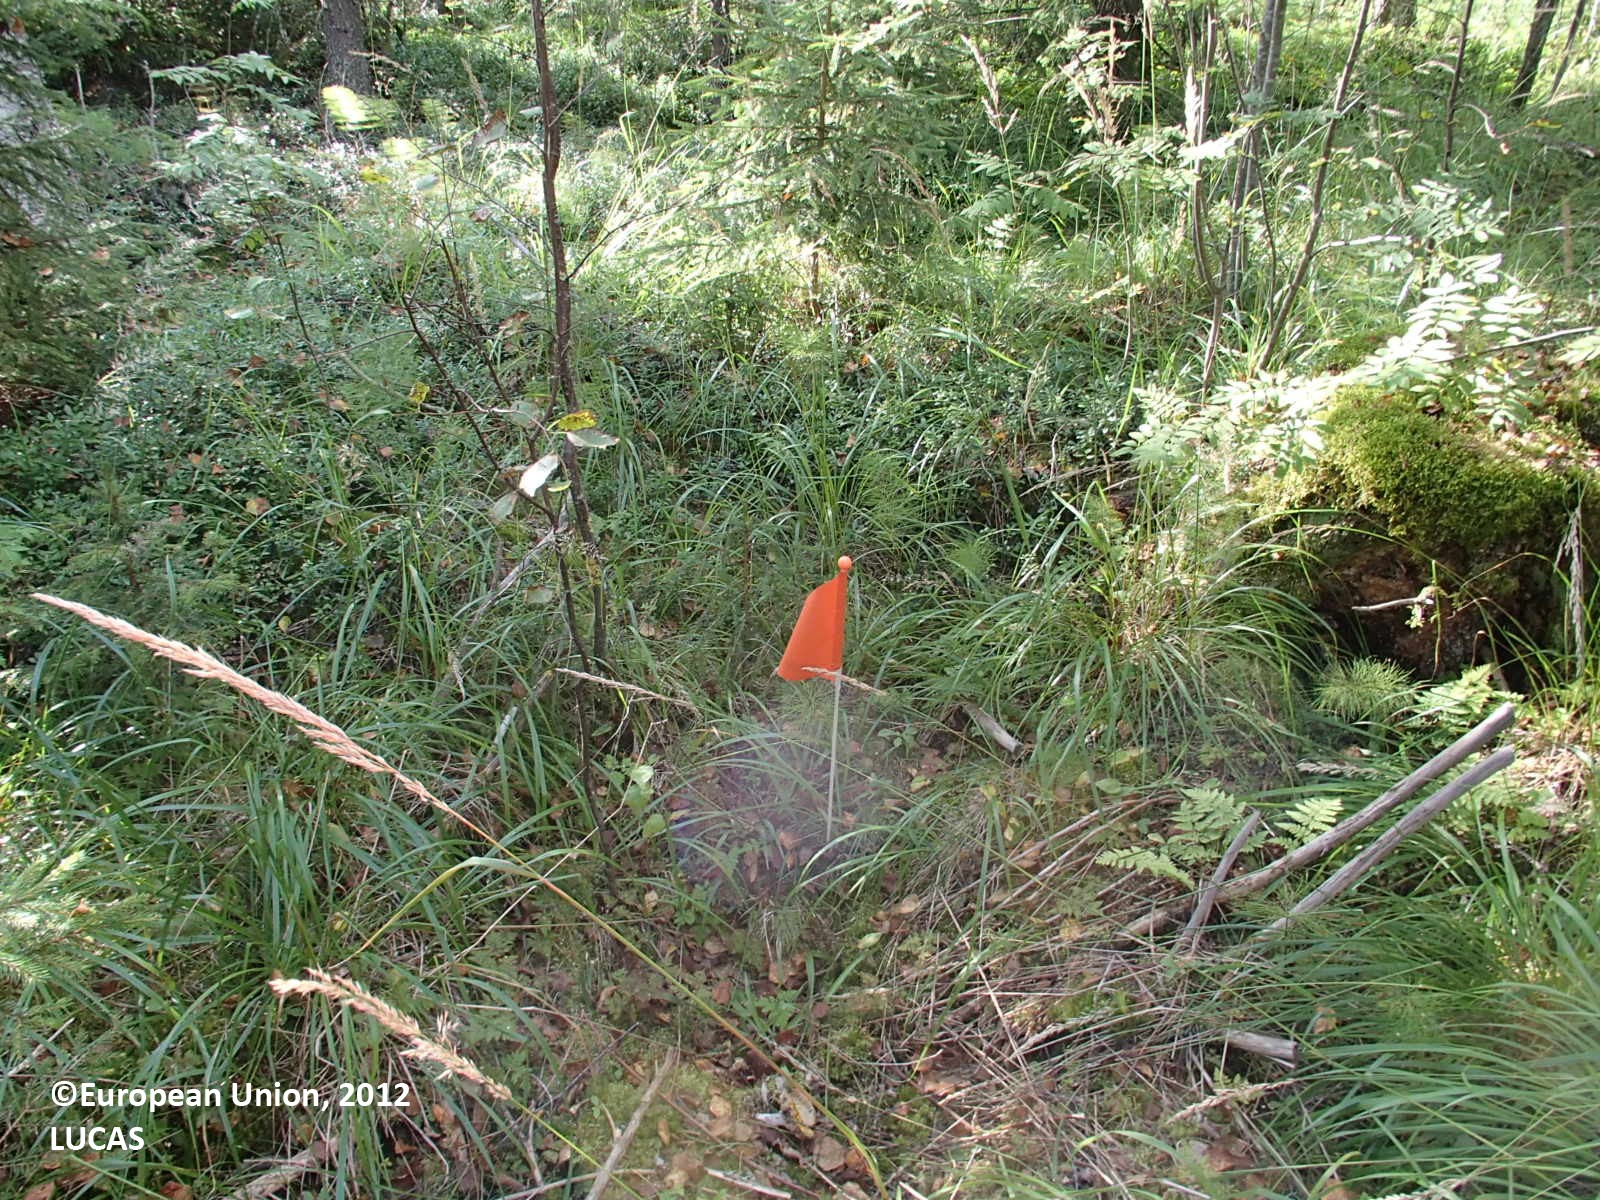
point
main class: Woodland
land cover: Spruce dominated mixed woodland
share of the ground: > 75 %
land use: Forestry
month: August
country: FI
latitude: 63.4571
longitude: 27.9210
